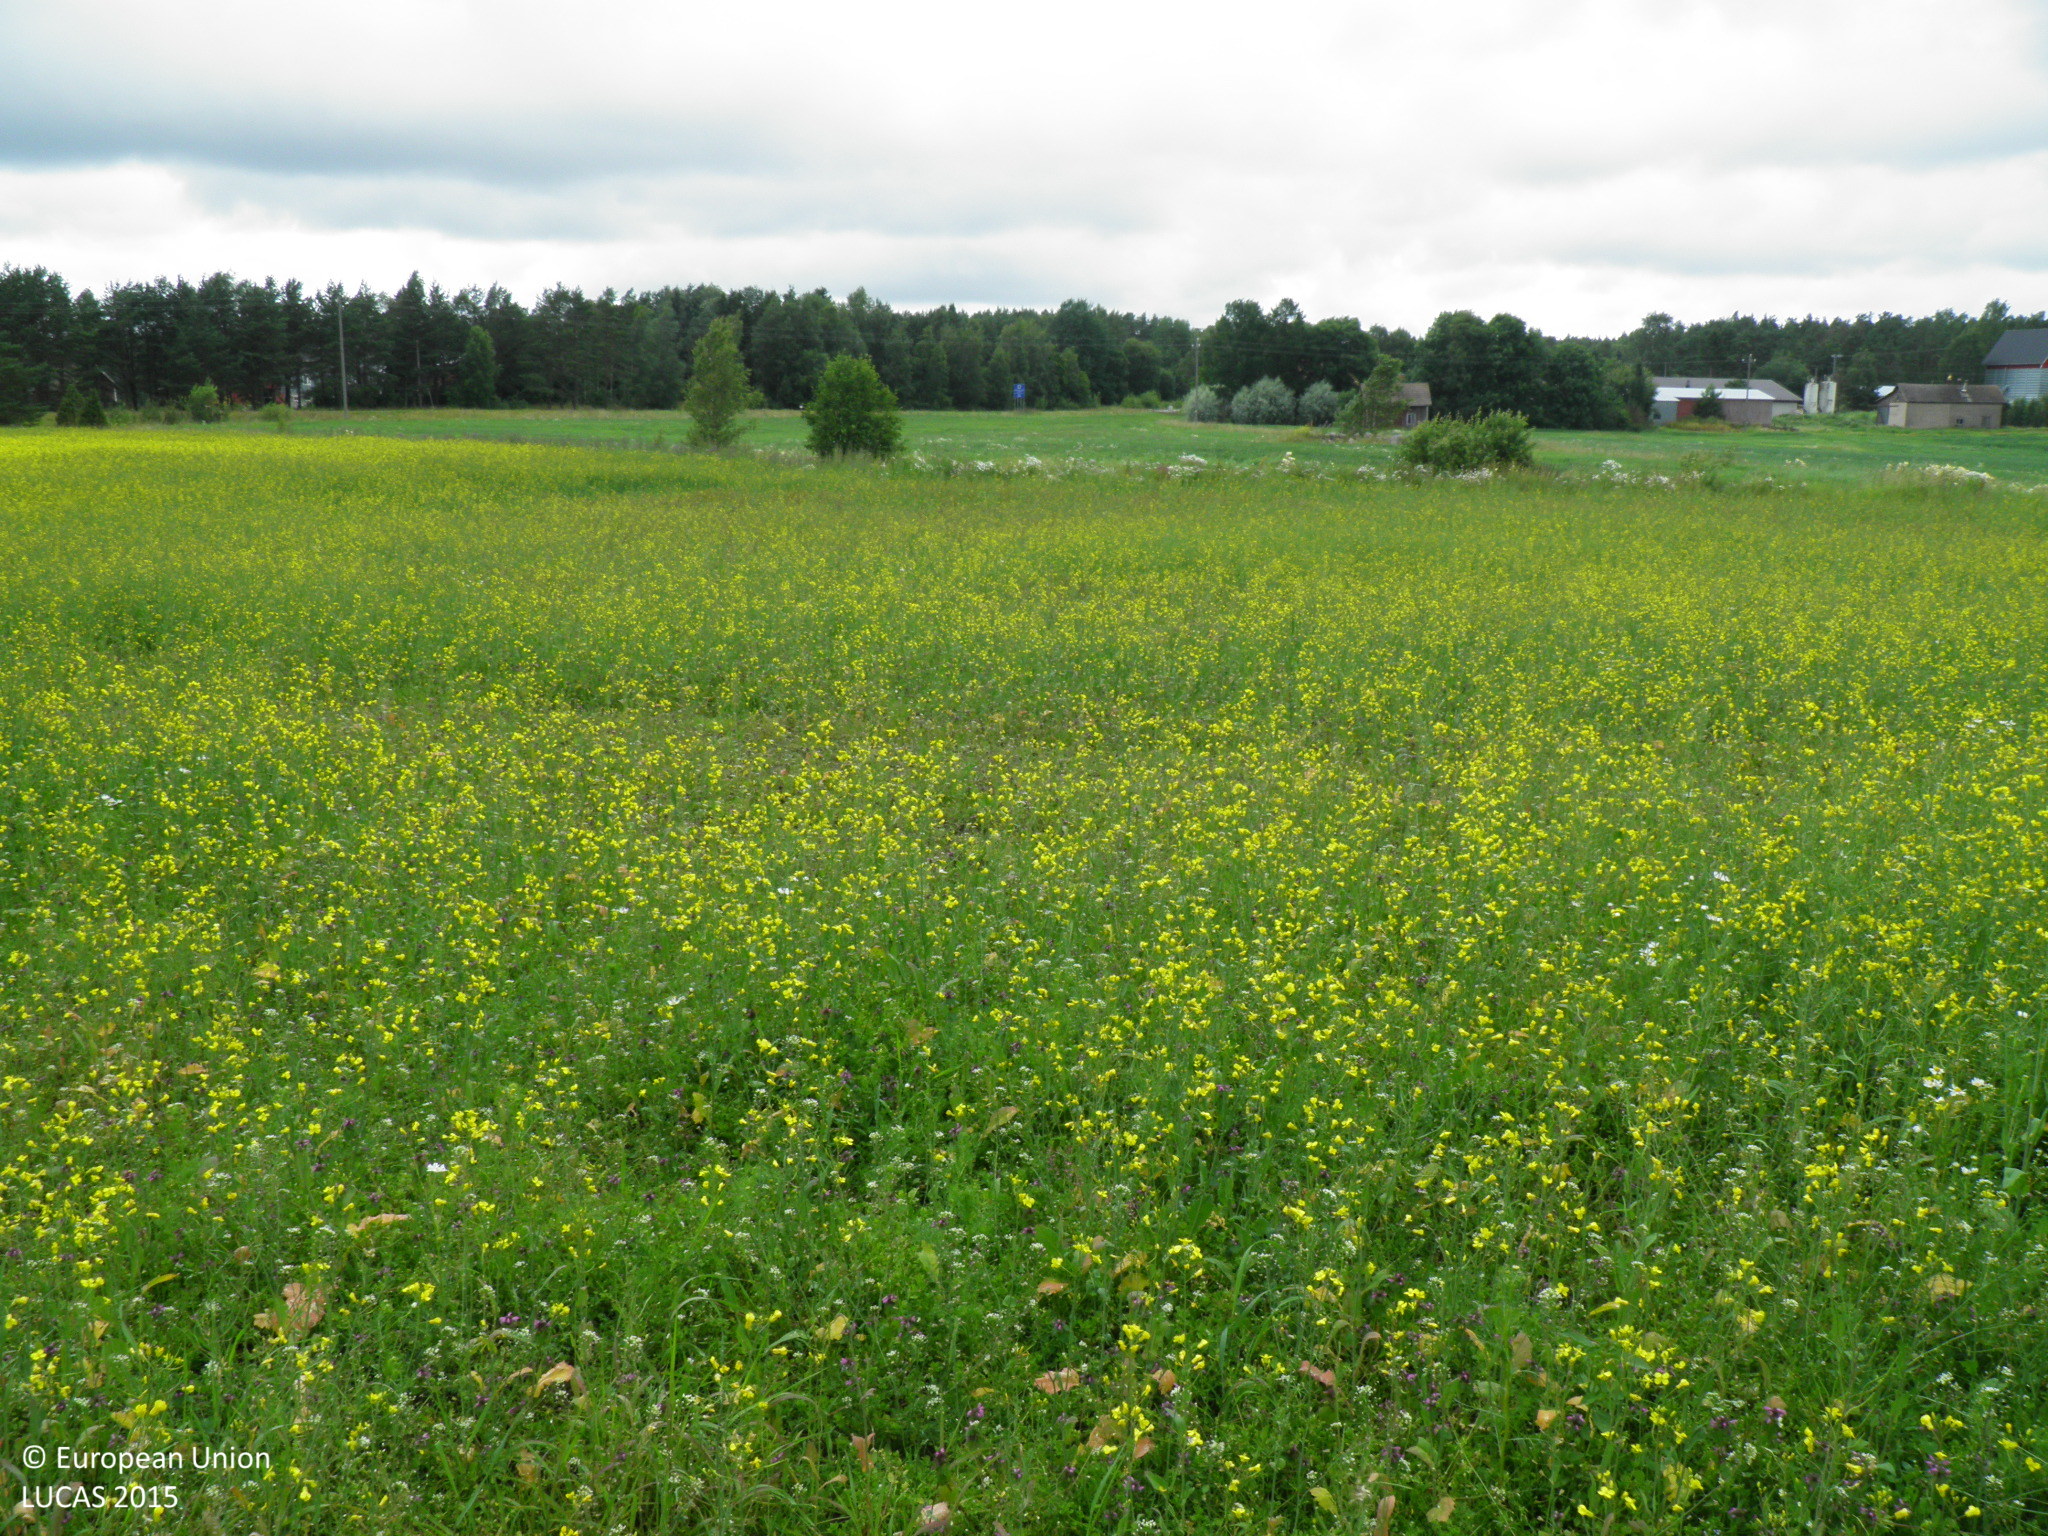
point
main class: Cropland
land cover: Rape and turnip rape
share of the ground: > 75 %
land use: Agriculture (excluding fallow land and kitchen gardens)
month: July
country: FI
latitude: 60.6158
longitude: 21.5489
